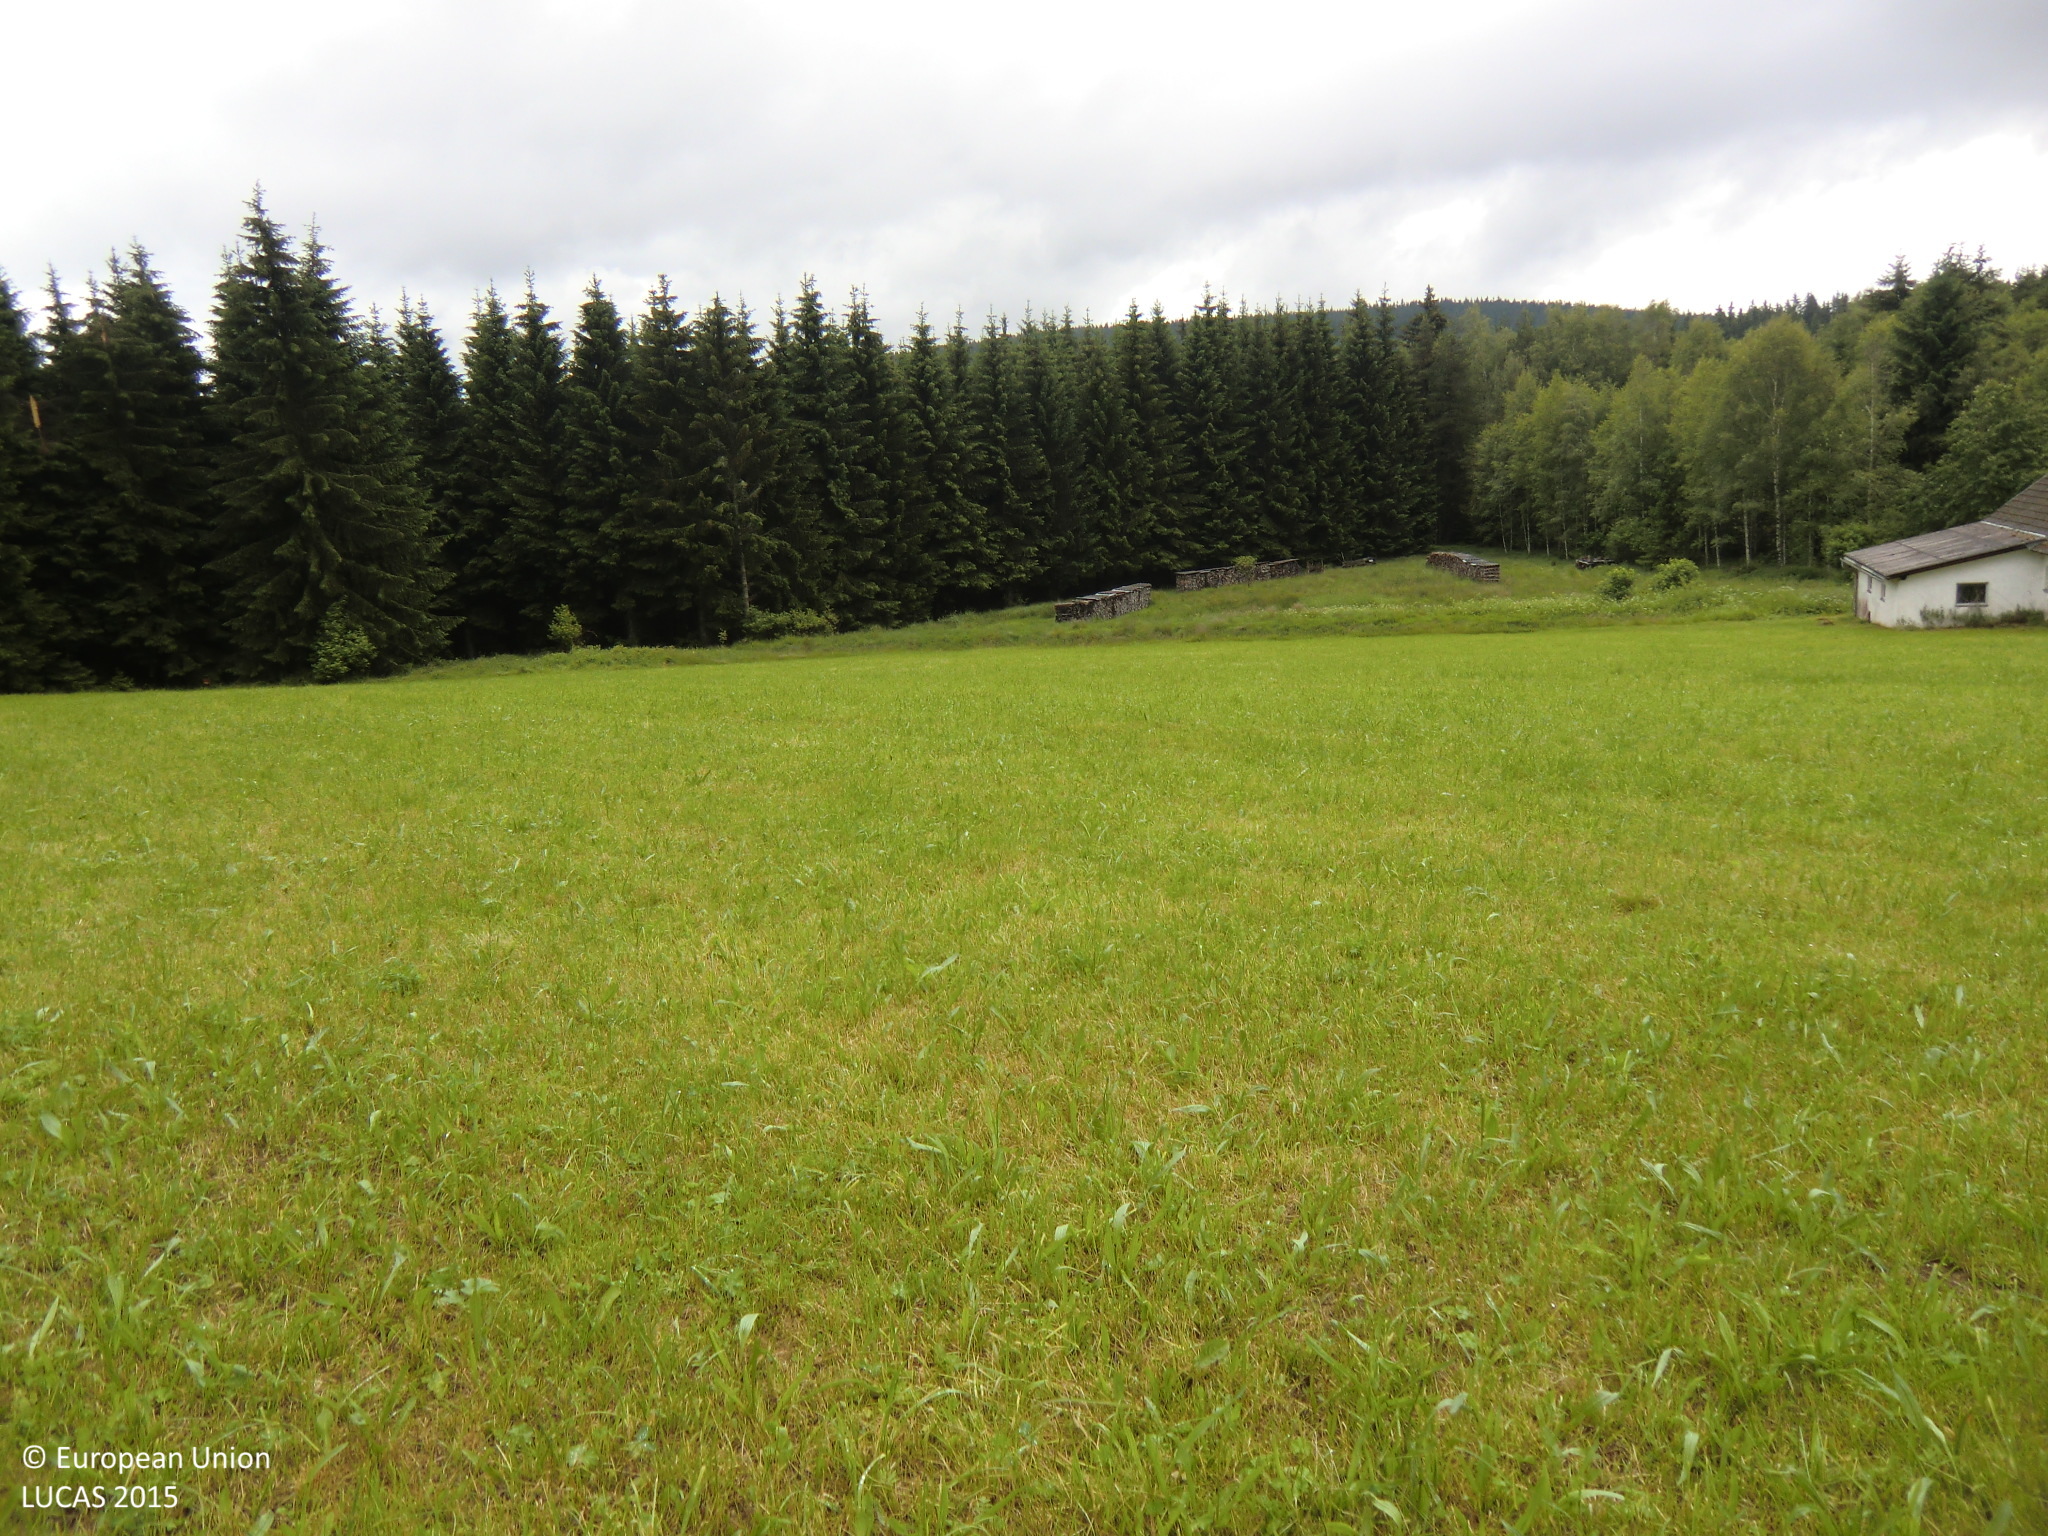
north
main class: Grassland
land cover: Grassland without tree/shrub cover
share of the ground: > 75 %
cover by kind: herbaceous plants 100 %
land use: Agriculture (excluding fallow land and kitchen gardens)
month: June
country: AT
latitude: 48.5413
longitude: 14.6197
